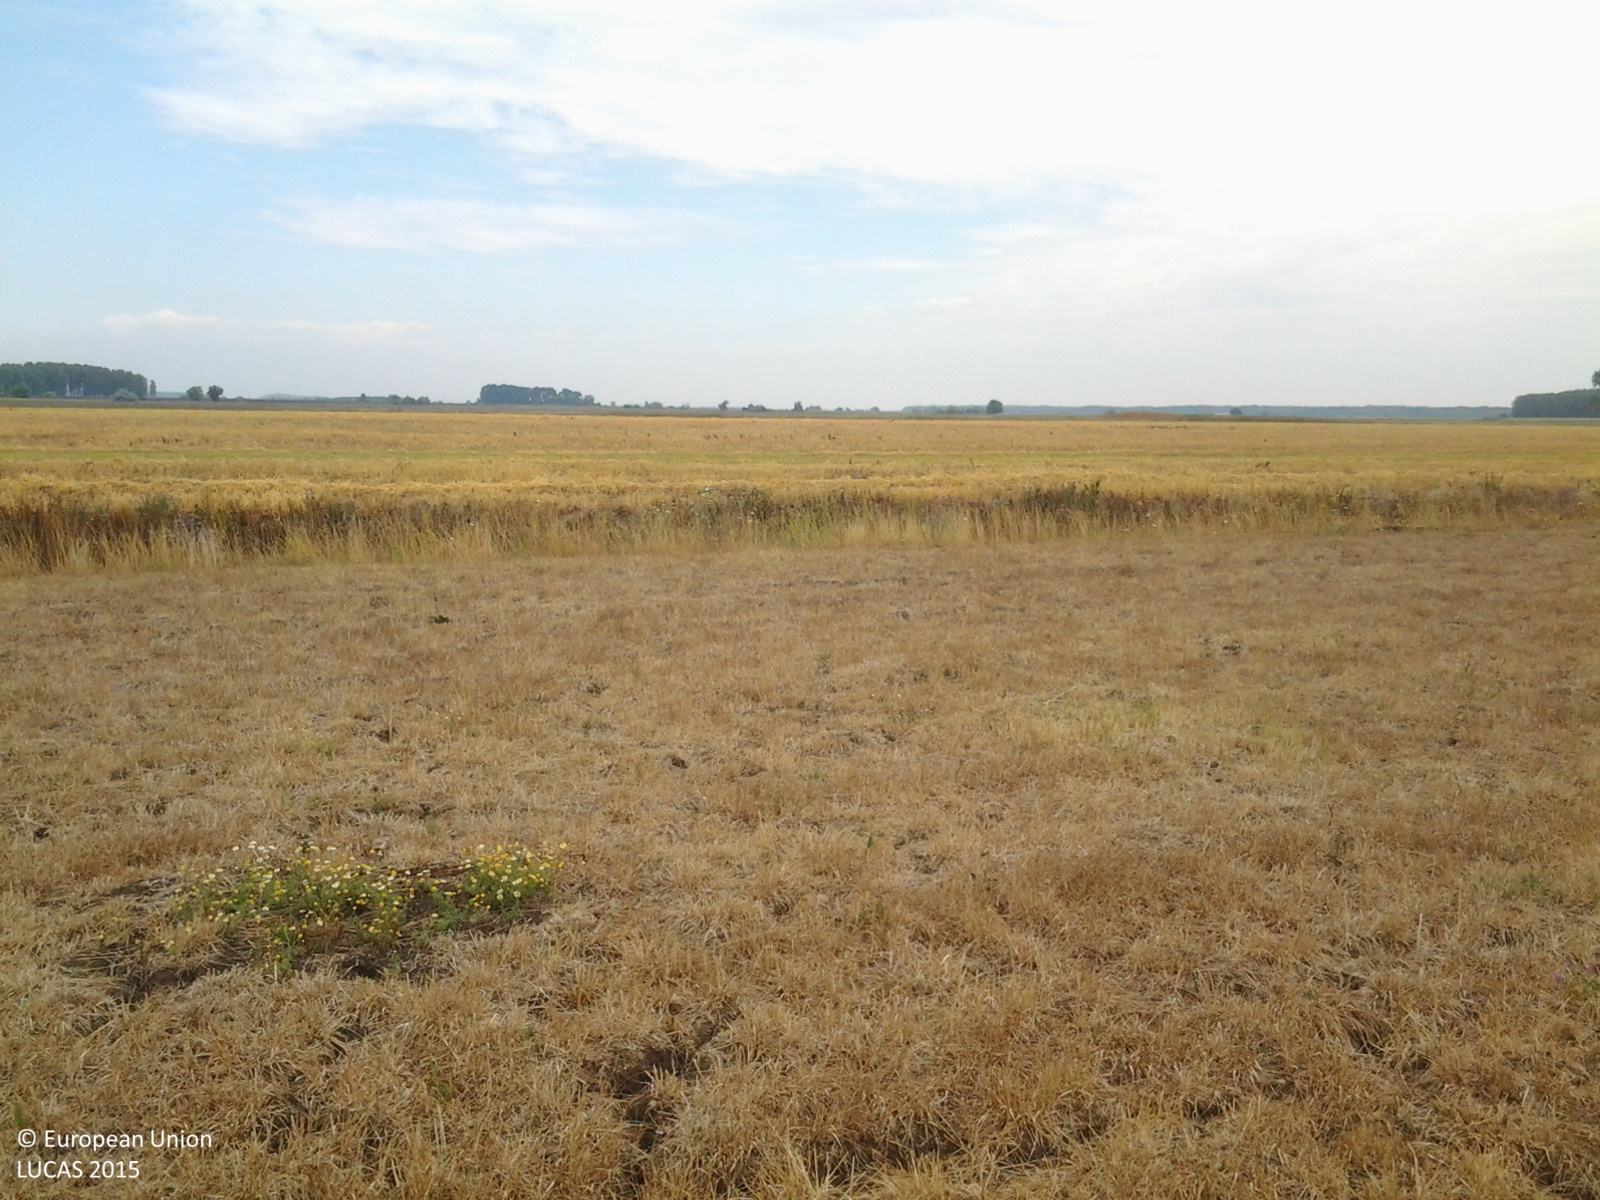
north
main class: Grassland
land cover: Grassland without tree/shrub cover
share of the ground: > 75 %
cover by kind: herbaceous plants 100 %
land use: Agriculture (excluding fallow land and kitchen gardens)
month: August
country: HU
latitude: 47.0322
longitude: 21.2090
